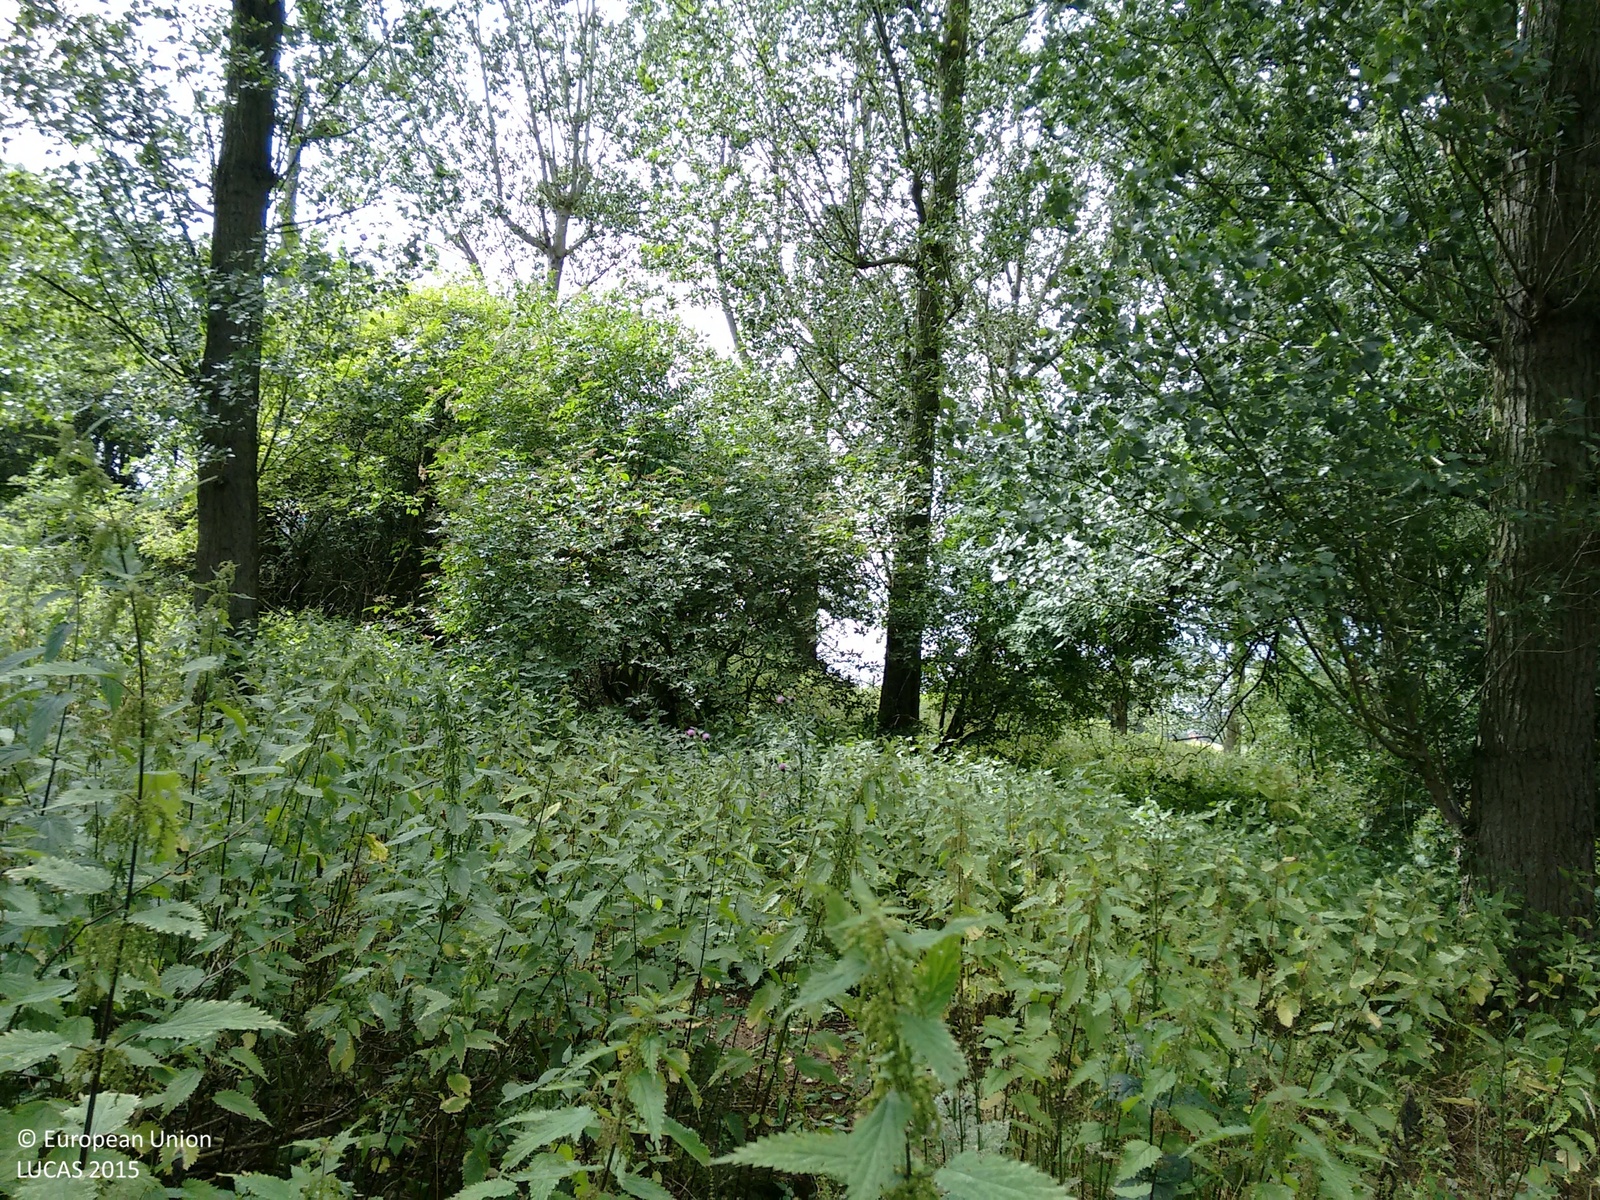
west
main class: Woodland
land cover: Broadleaved woodland
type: mesophytic deciduous forest
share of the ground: > 75 %
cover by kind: broadleaved forest trees 90 %, shrubs 5 %, herbaceous plants 5 %
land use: Semi-natural and natural areas not in use
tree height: > 5 m
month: July
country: GB
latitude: 51.6899
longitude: 0.0879
